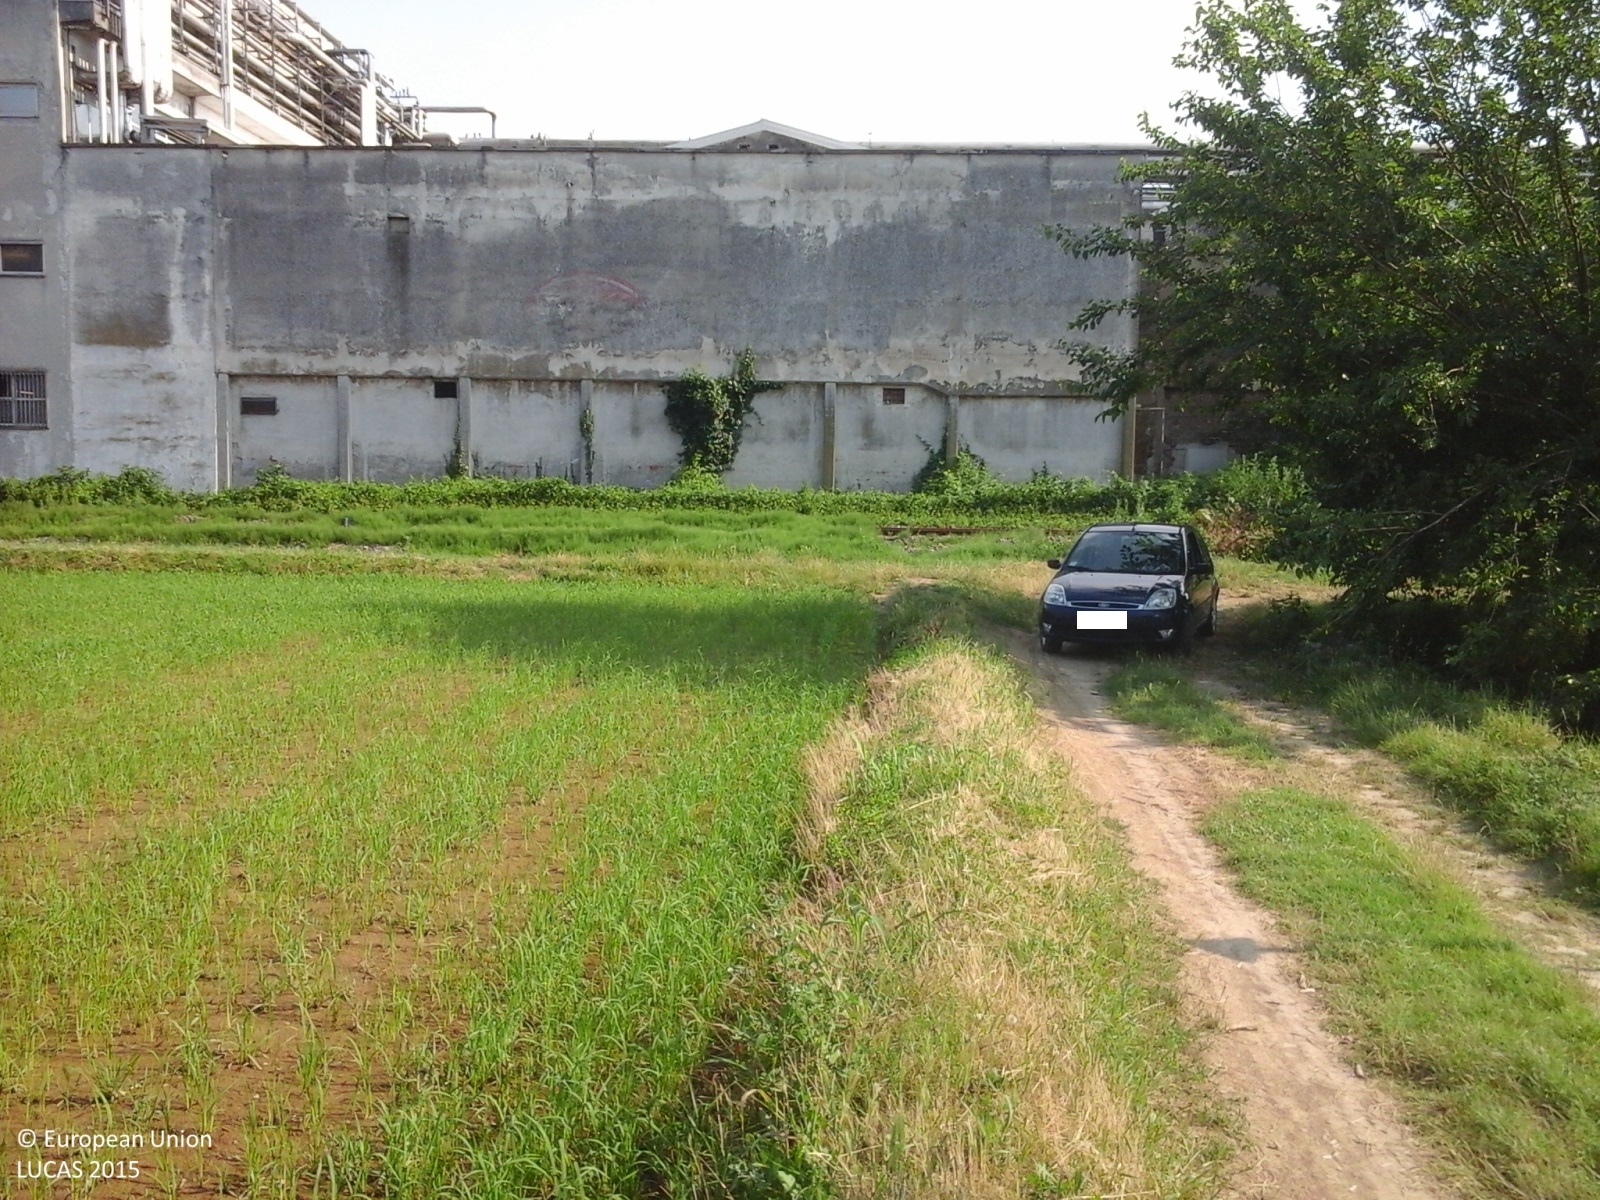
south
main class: Cropland
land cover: Rice
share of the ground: > 75 %
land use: Agriculture (excluding fallow land and kitchen gardens)
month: June
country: IT
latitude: 45.1601
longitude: 9.3778
